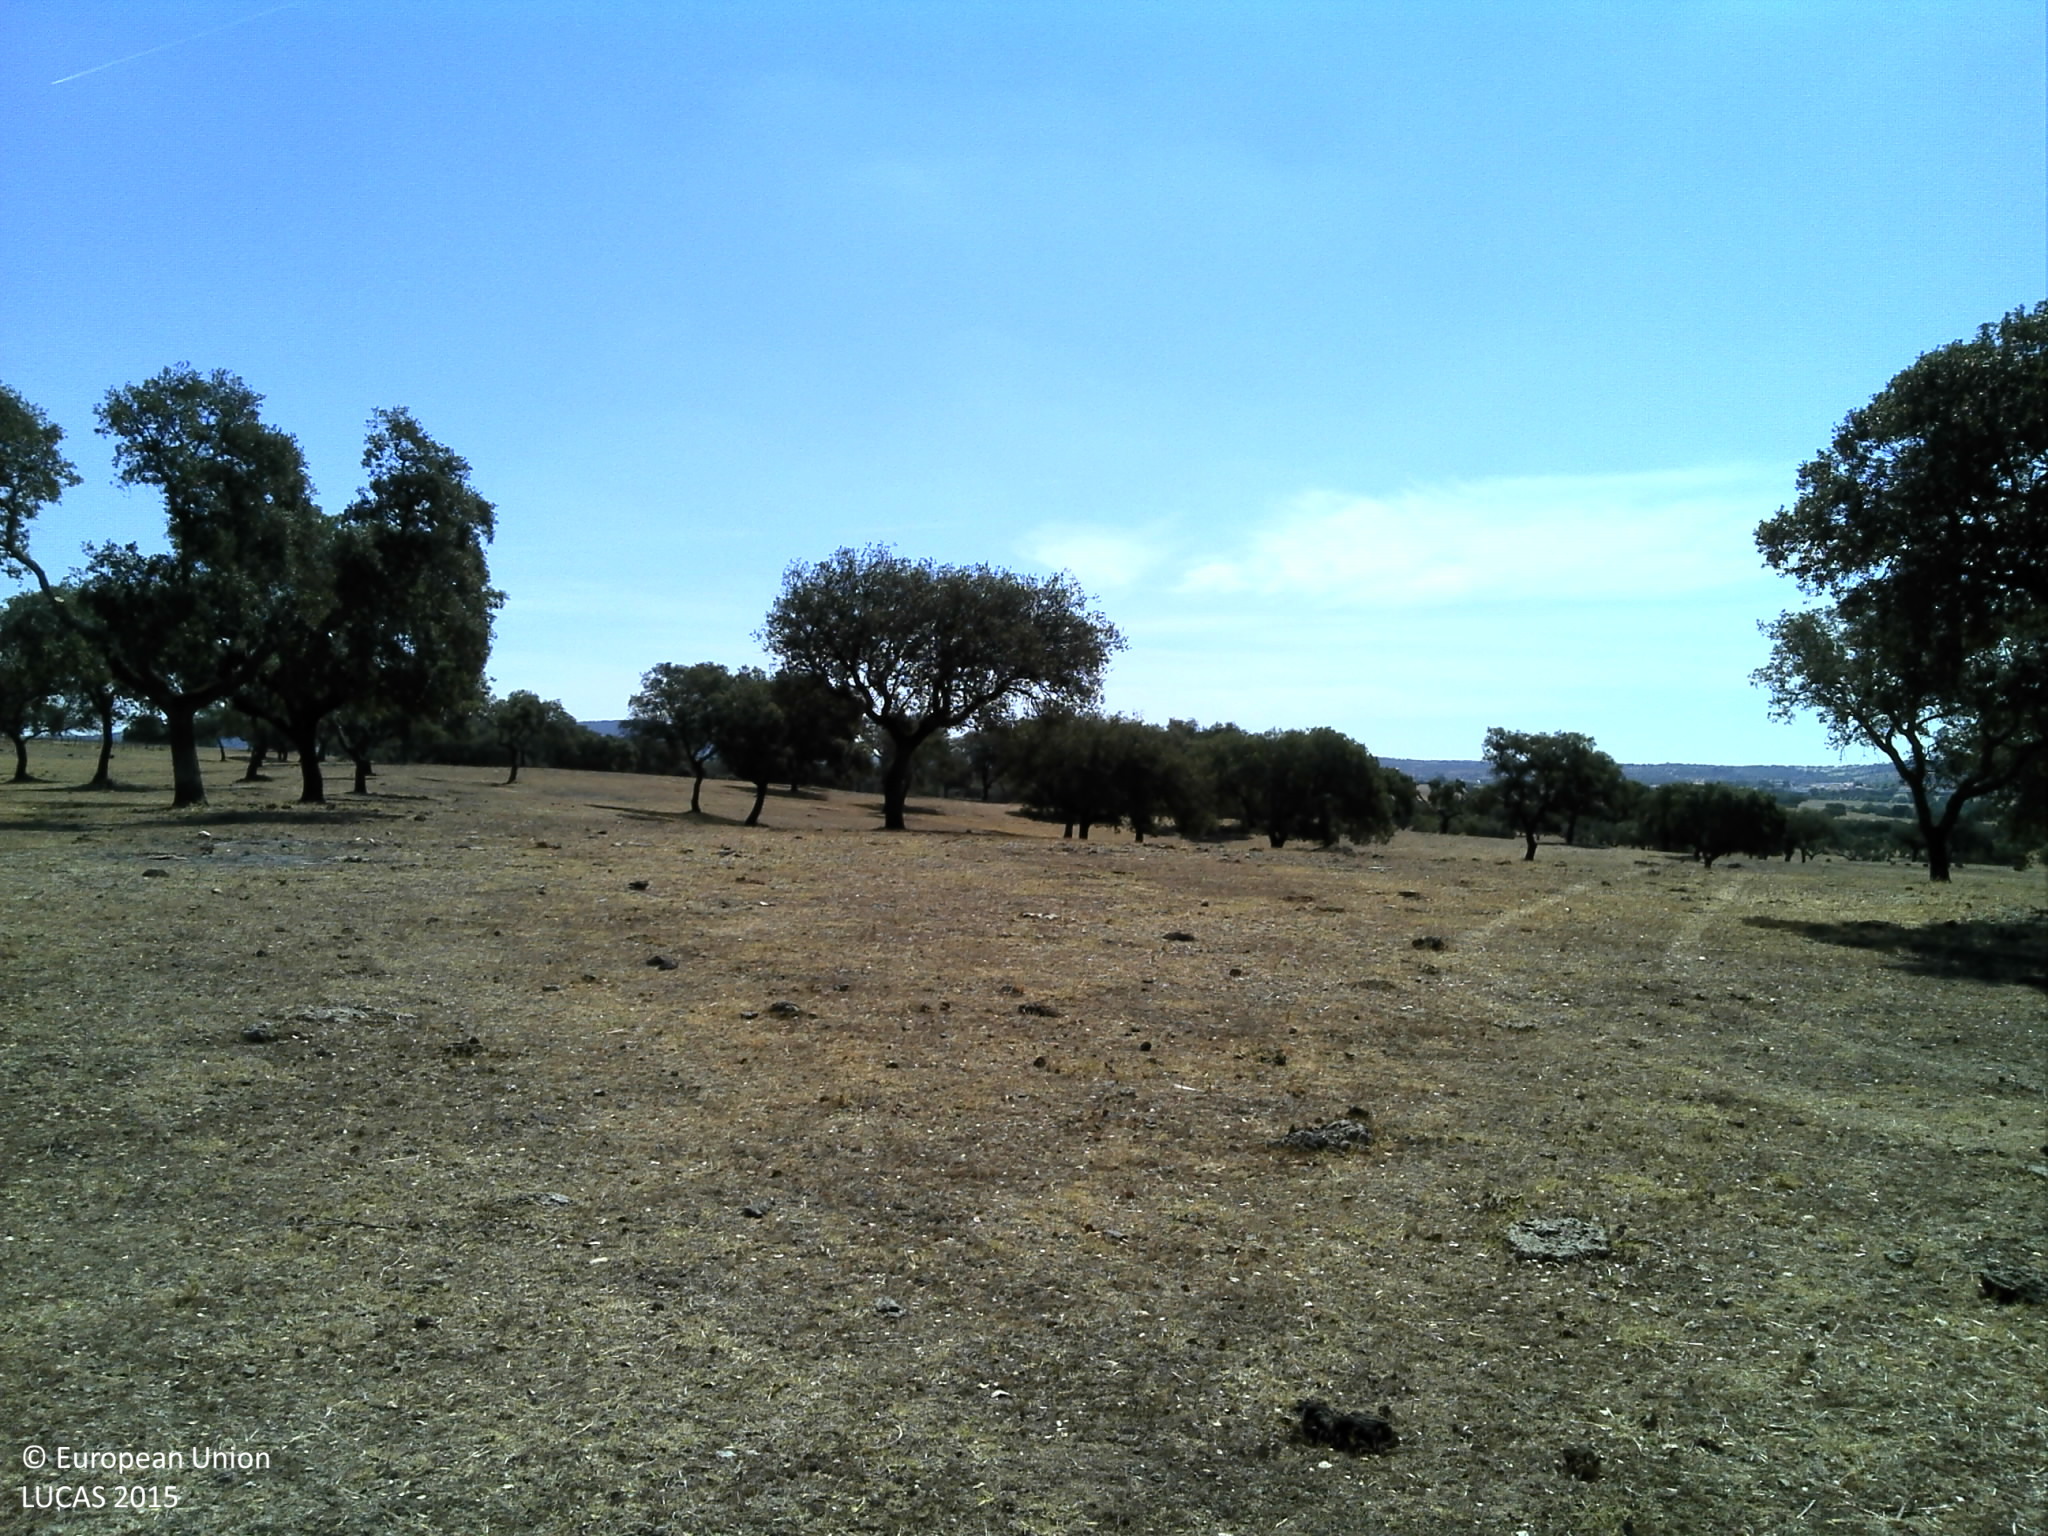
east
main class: Woodland
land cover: Broadleaved woodland
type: broadleaved evergreen forest
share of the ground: 10 - 25 %
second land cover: Grassland without tree/shrub cover
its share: < 10 %
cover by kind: unconsolidated bare surface 80 %, broadleaved forest trees 10 %, herbaceous plants 10 %
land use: Forestry
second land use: Agriculture (excluding fallow land and kitchen gardens)
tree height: > 5 m
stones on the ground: < 10 %
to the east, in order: Broadleaved woodland; Grassland without tree/shrub cover; Broadleaved woodland; Grassland without tree/shrub cover; Inland fresh water bodies
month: June
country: PT
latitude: 38.2963
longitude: -8.0699
